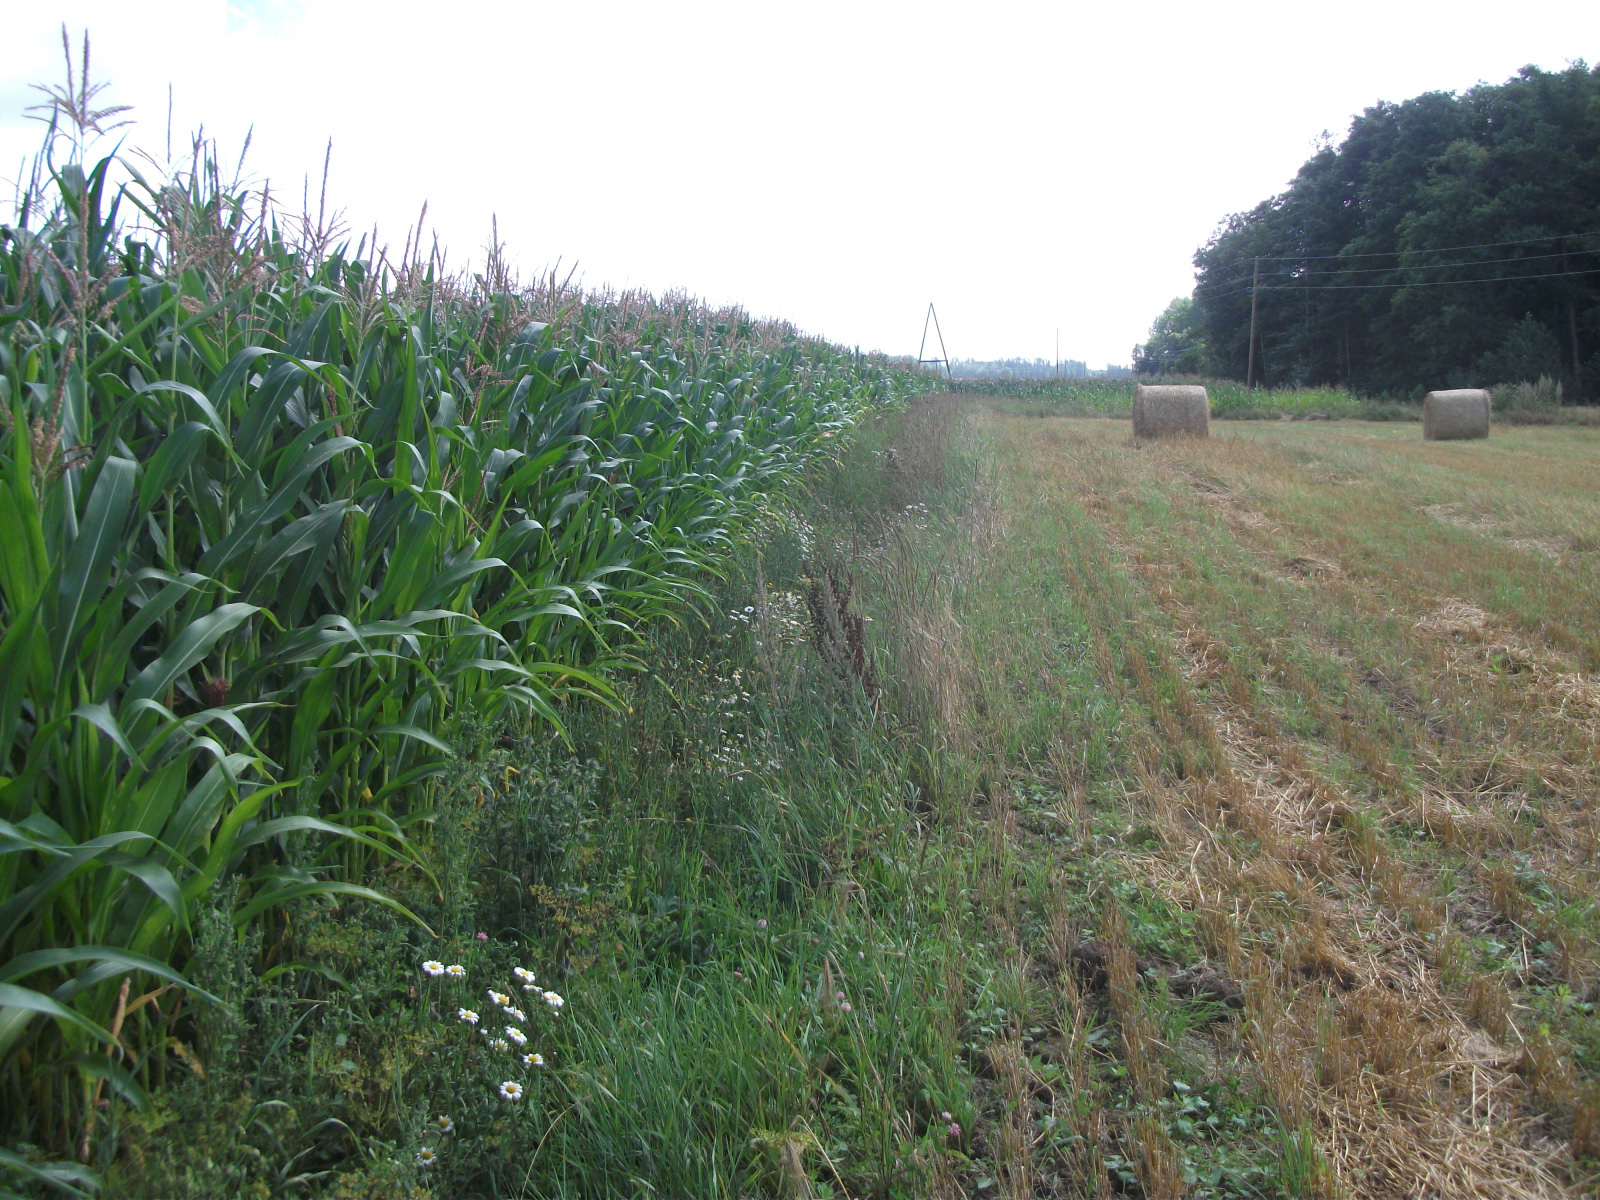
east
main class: Cropland
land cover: Maize
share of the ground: > 75 %
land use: Agriculture (excluding fallow land and kitchen gardens)
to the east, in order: Maize
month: August
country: LV
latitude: 56.4187
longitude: 26.4715
